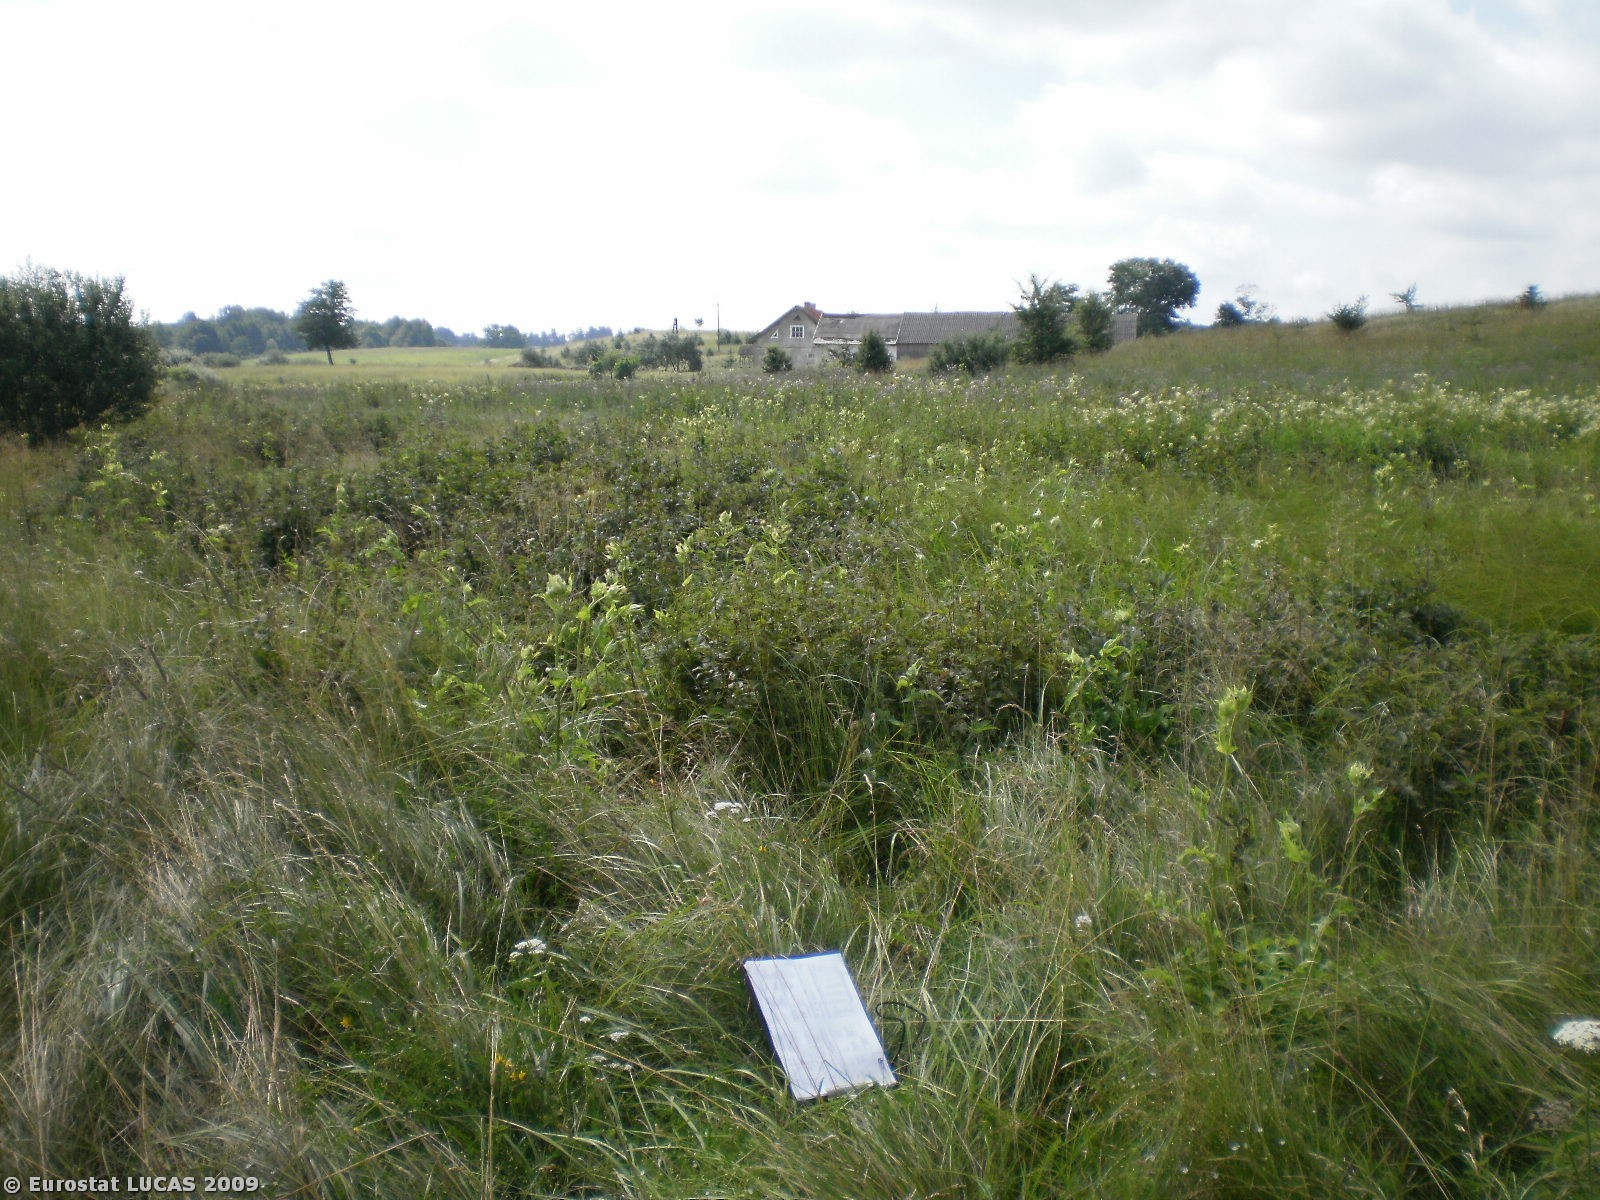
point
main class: Grassland
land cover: Grassland without tree/shrub cover
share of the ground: > 75 %
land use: Unused
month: July
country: PL
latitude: 53.9490
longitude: 19.9807
